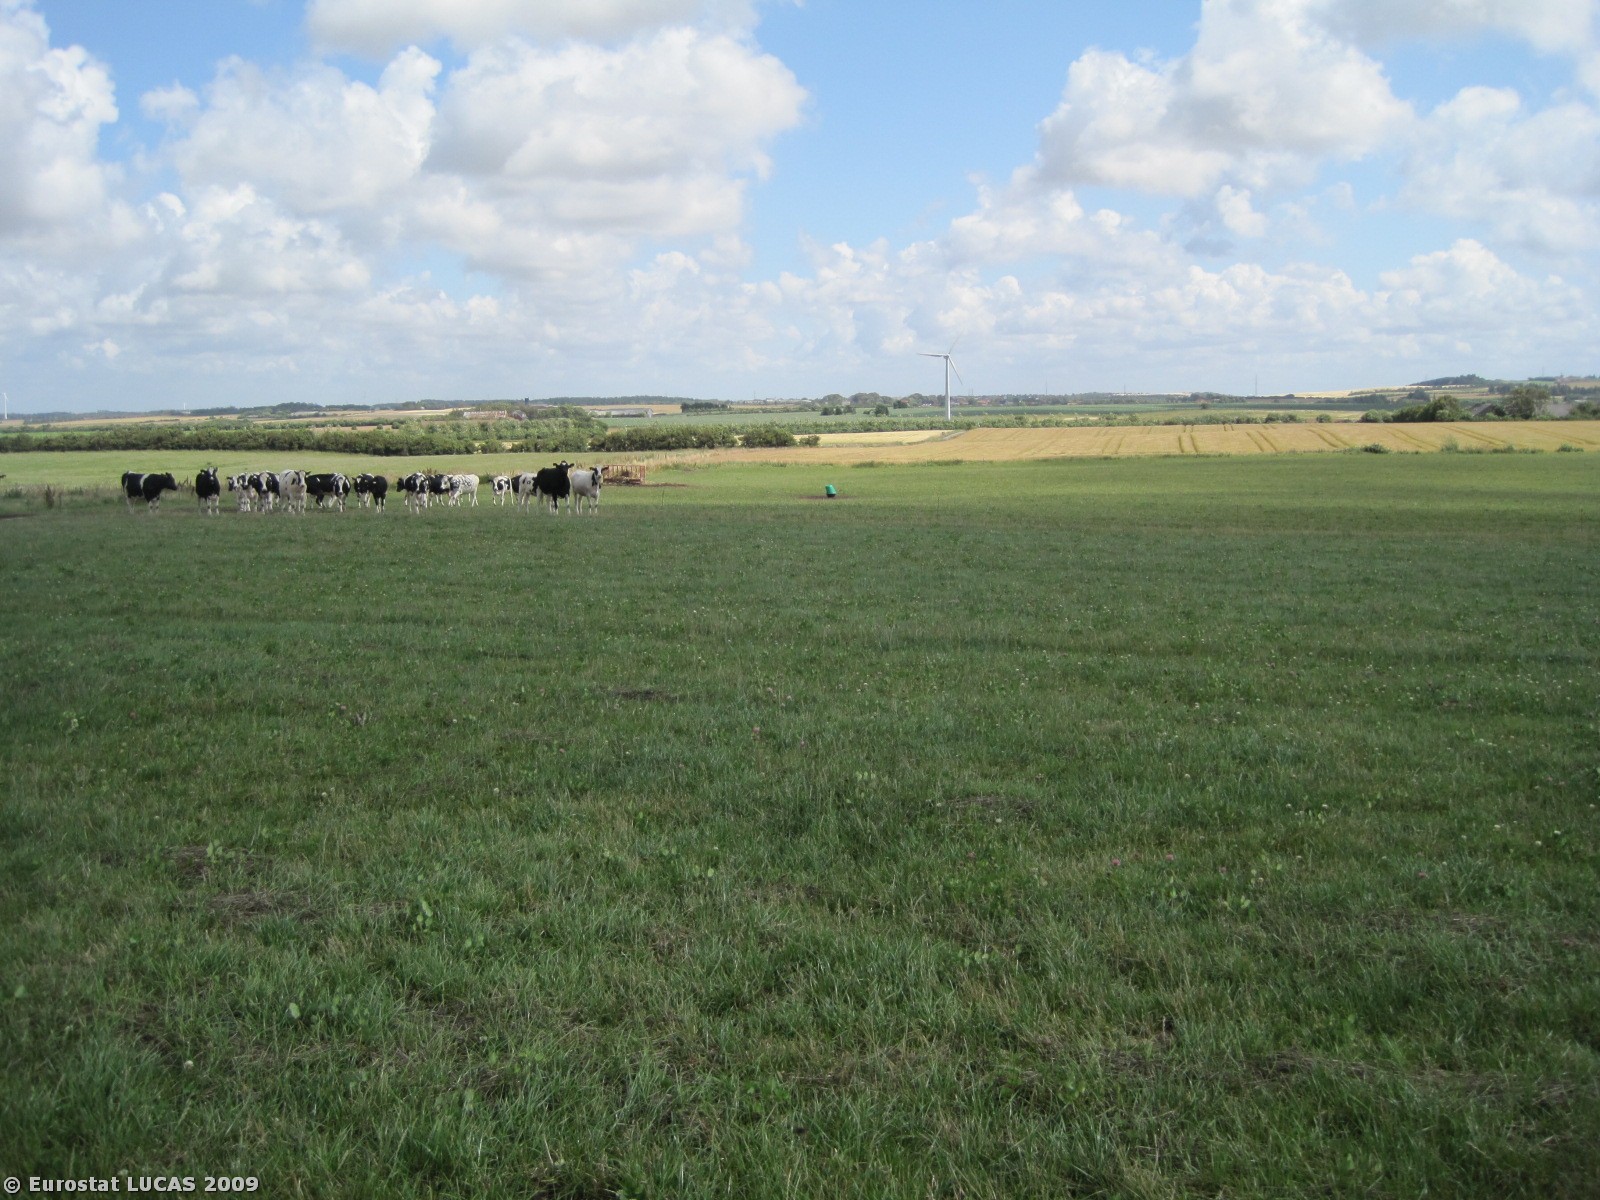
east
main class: Grassland
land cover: Grassland without tree/shrub cover
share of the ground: > 75 %
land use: Agriculture (excluding fallow land and kitchen gardens)
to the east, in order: Grassland without tree/shrub cover; Fences; Grassland without tree/shrub cover; Fences; Grass margins; Ditches and canals; Grass margins; Common wheat
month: July
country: DK
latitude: 56.8252
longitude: 8.4127
